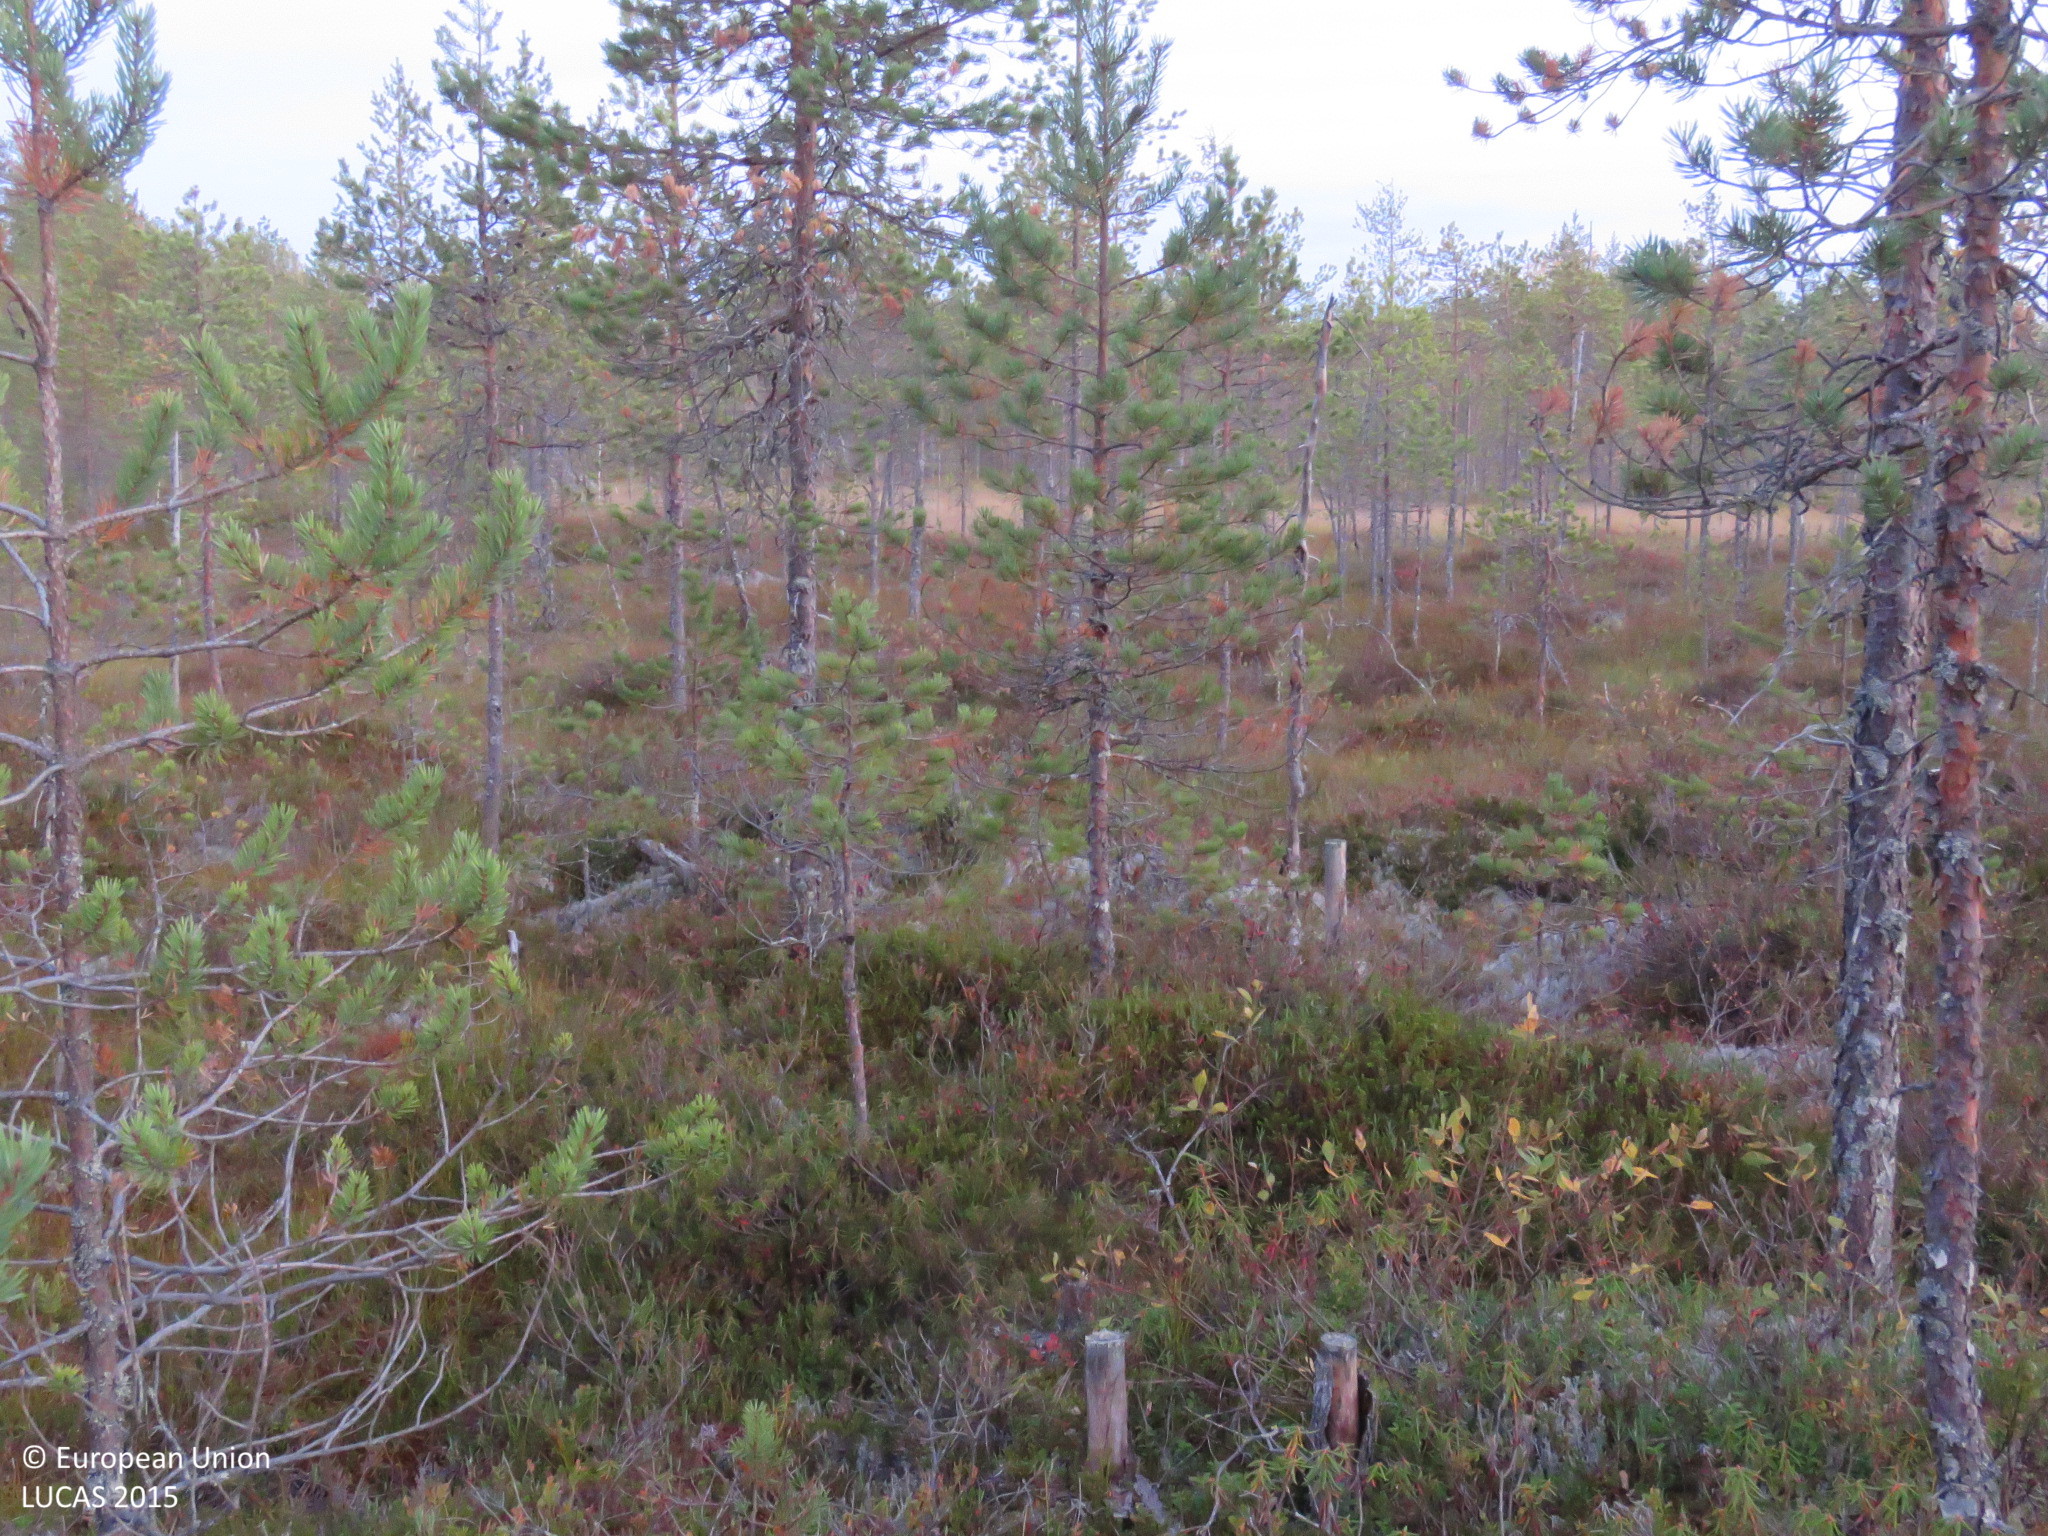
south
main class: Woodland
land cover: Pine dominated coniferous woodland
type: boreal forest
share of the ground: 50 - 75 %
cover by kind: coniferous forest trees 65 %, shrubs 15 %, lichens and mosses 15 %, herbaceous plants 5 %
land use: Semi-natural and natural areas not in use
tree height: < 5 m
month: September
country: FI
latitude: 64.8040
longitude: 26.5109
